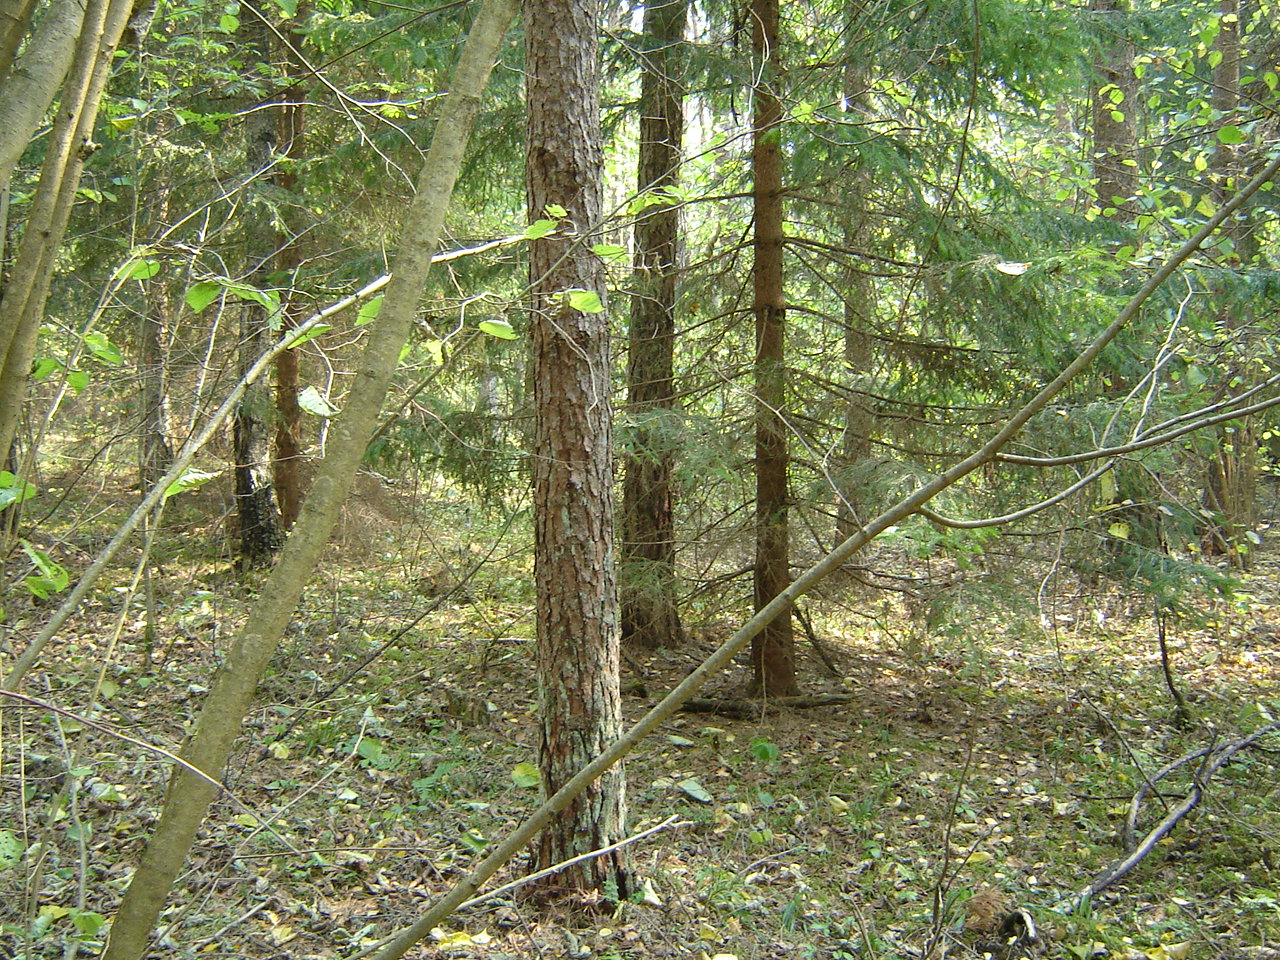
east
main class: Woodland
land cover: Pine dominated mixed woodland
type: hemiboreal forest and nemoral coniferous forest and mixed broadleaved-coniferous forest
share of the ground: > 75 %
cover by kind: coniferous forest trees 60 %, broadleaved forest trees 30 %, unconsolidated bare surface 10 %
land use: Forestry
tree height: > 5 m
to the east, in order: Pine dominated mixed woodland; Tracks; Pine dominated mixed woodland; Tracks; Pine dominated mixed woodland
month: September
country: LT
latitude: 54.5537
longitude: 25.0995
